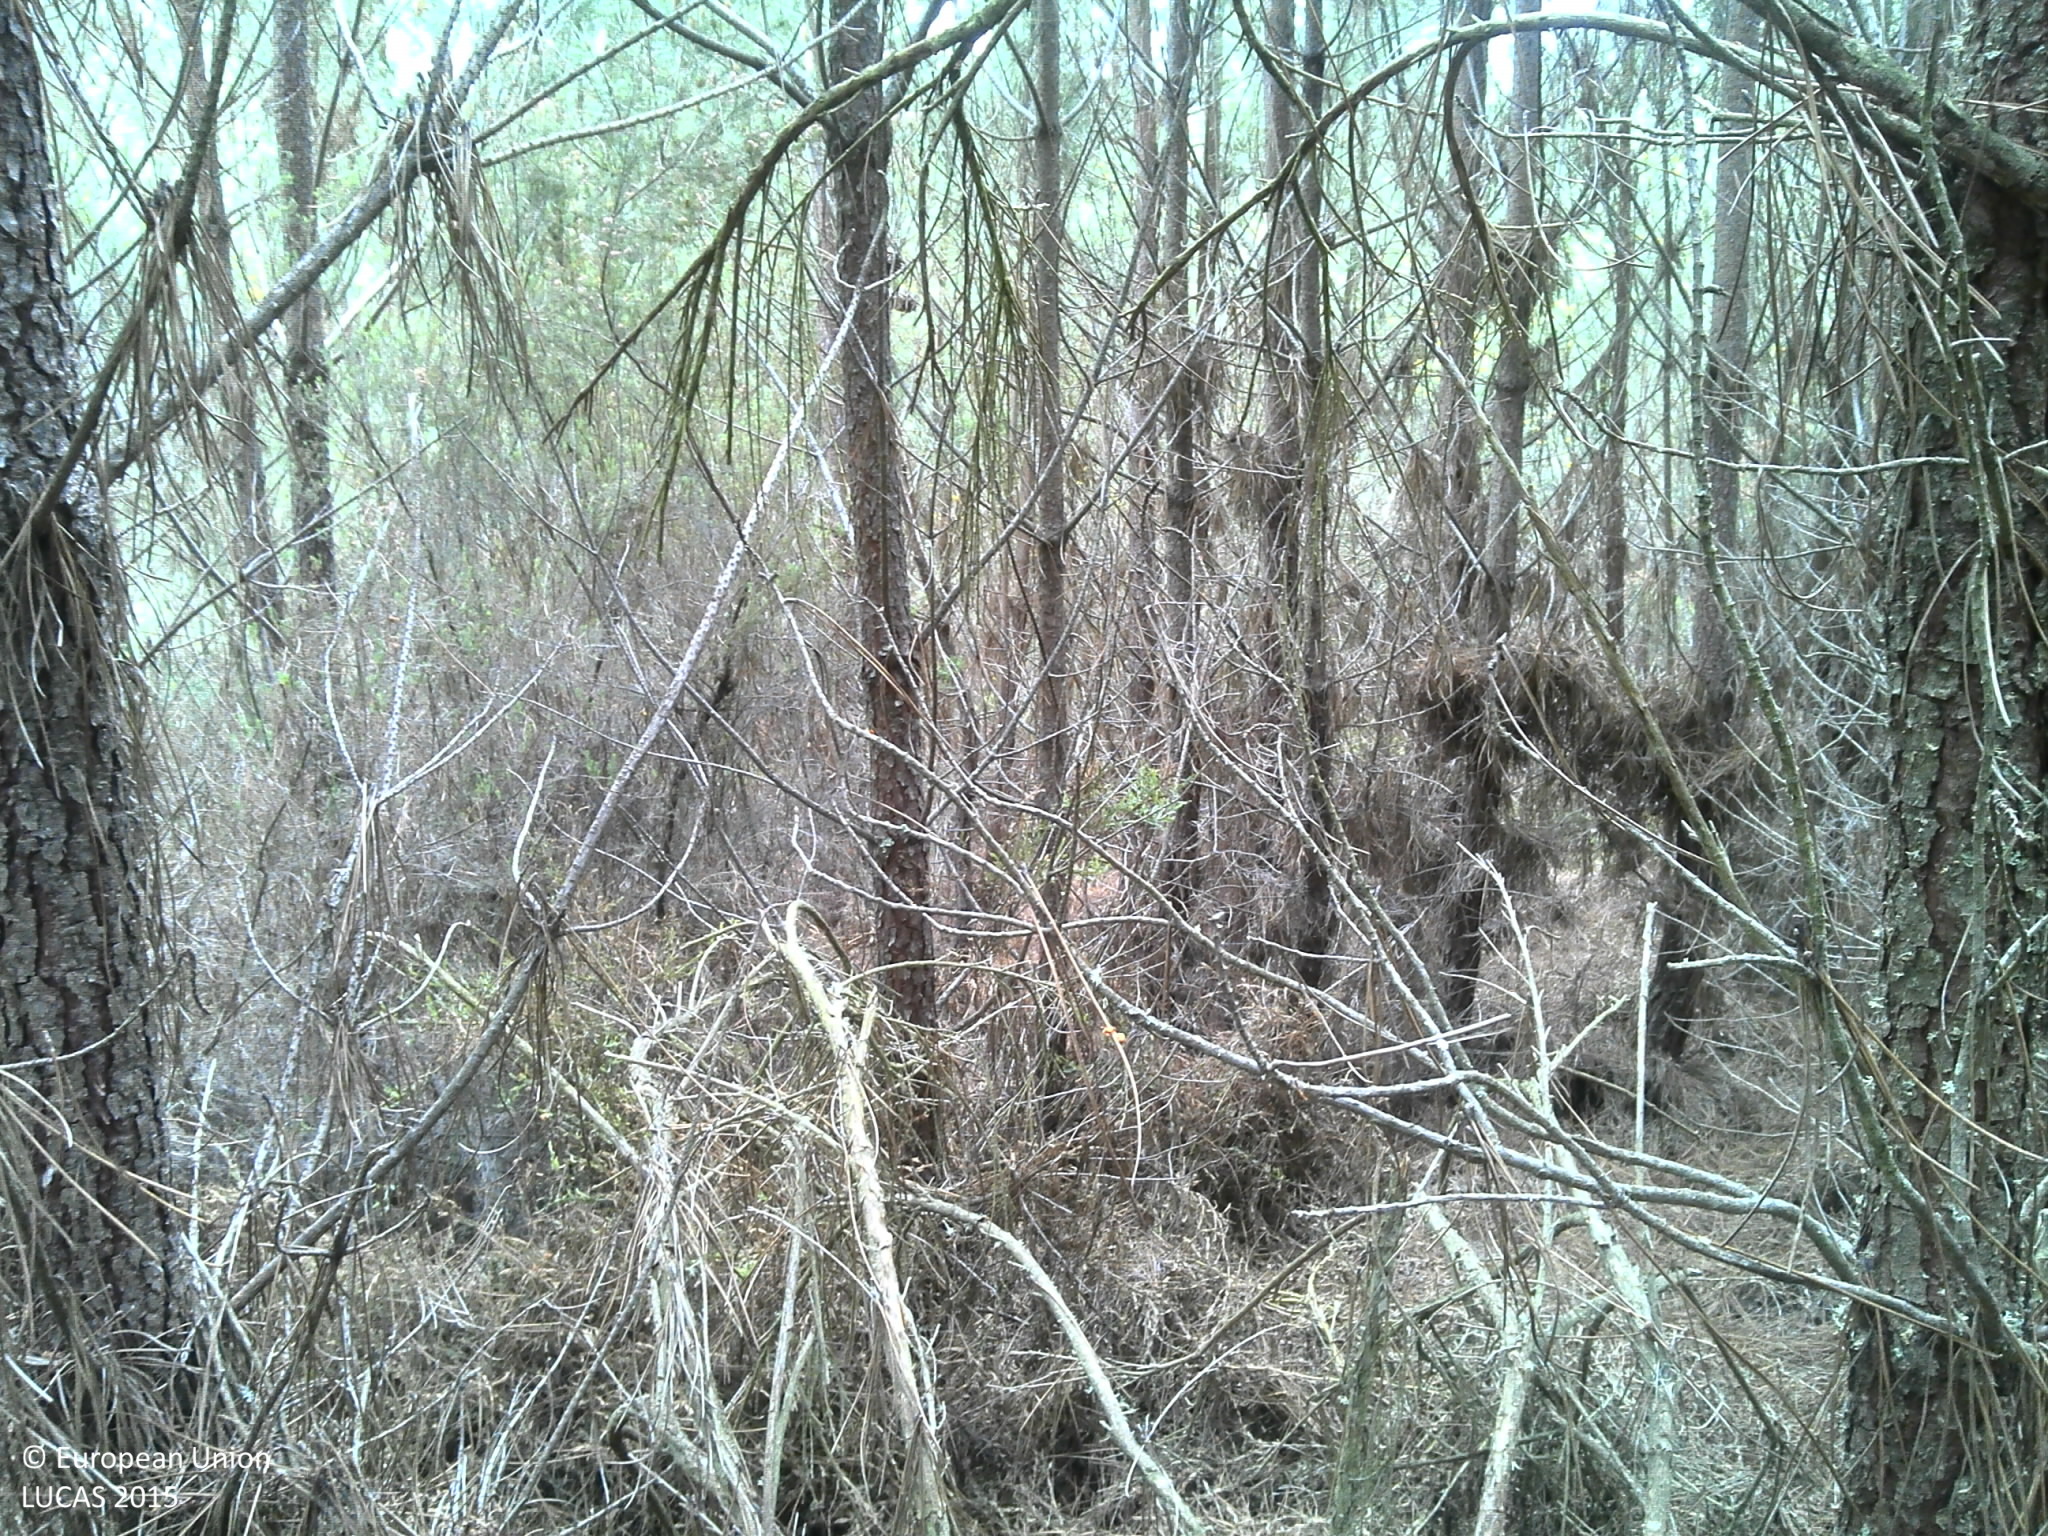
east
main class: Woodland
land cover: Pine dominated coniferous woodland
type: coniferous forest of the mediterranean region
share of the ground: > 75 %
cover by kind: coniferous forest trees 90 %, unconsolidated bare surface 10 %
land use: Forestry
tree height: > 5 m
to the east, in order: Pine dominated coniferous woodland; Shrubland with sparse tree cover; Grass margins; Tracks; Grass margins; Shrubland with sparse tree cover; Broadleaved woodland; Shrubland with sparse tree cover; Rivers and streams; Lines of trees; Grassland without tree/shrub cover
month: May
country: PT
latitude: 41.6353
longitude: -6.9579
